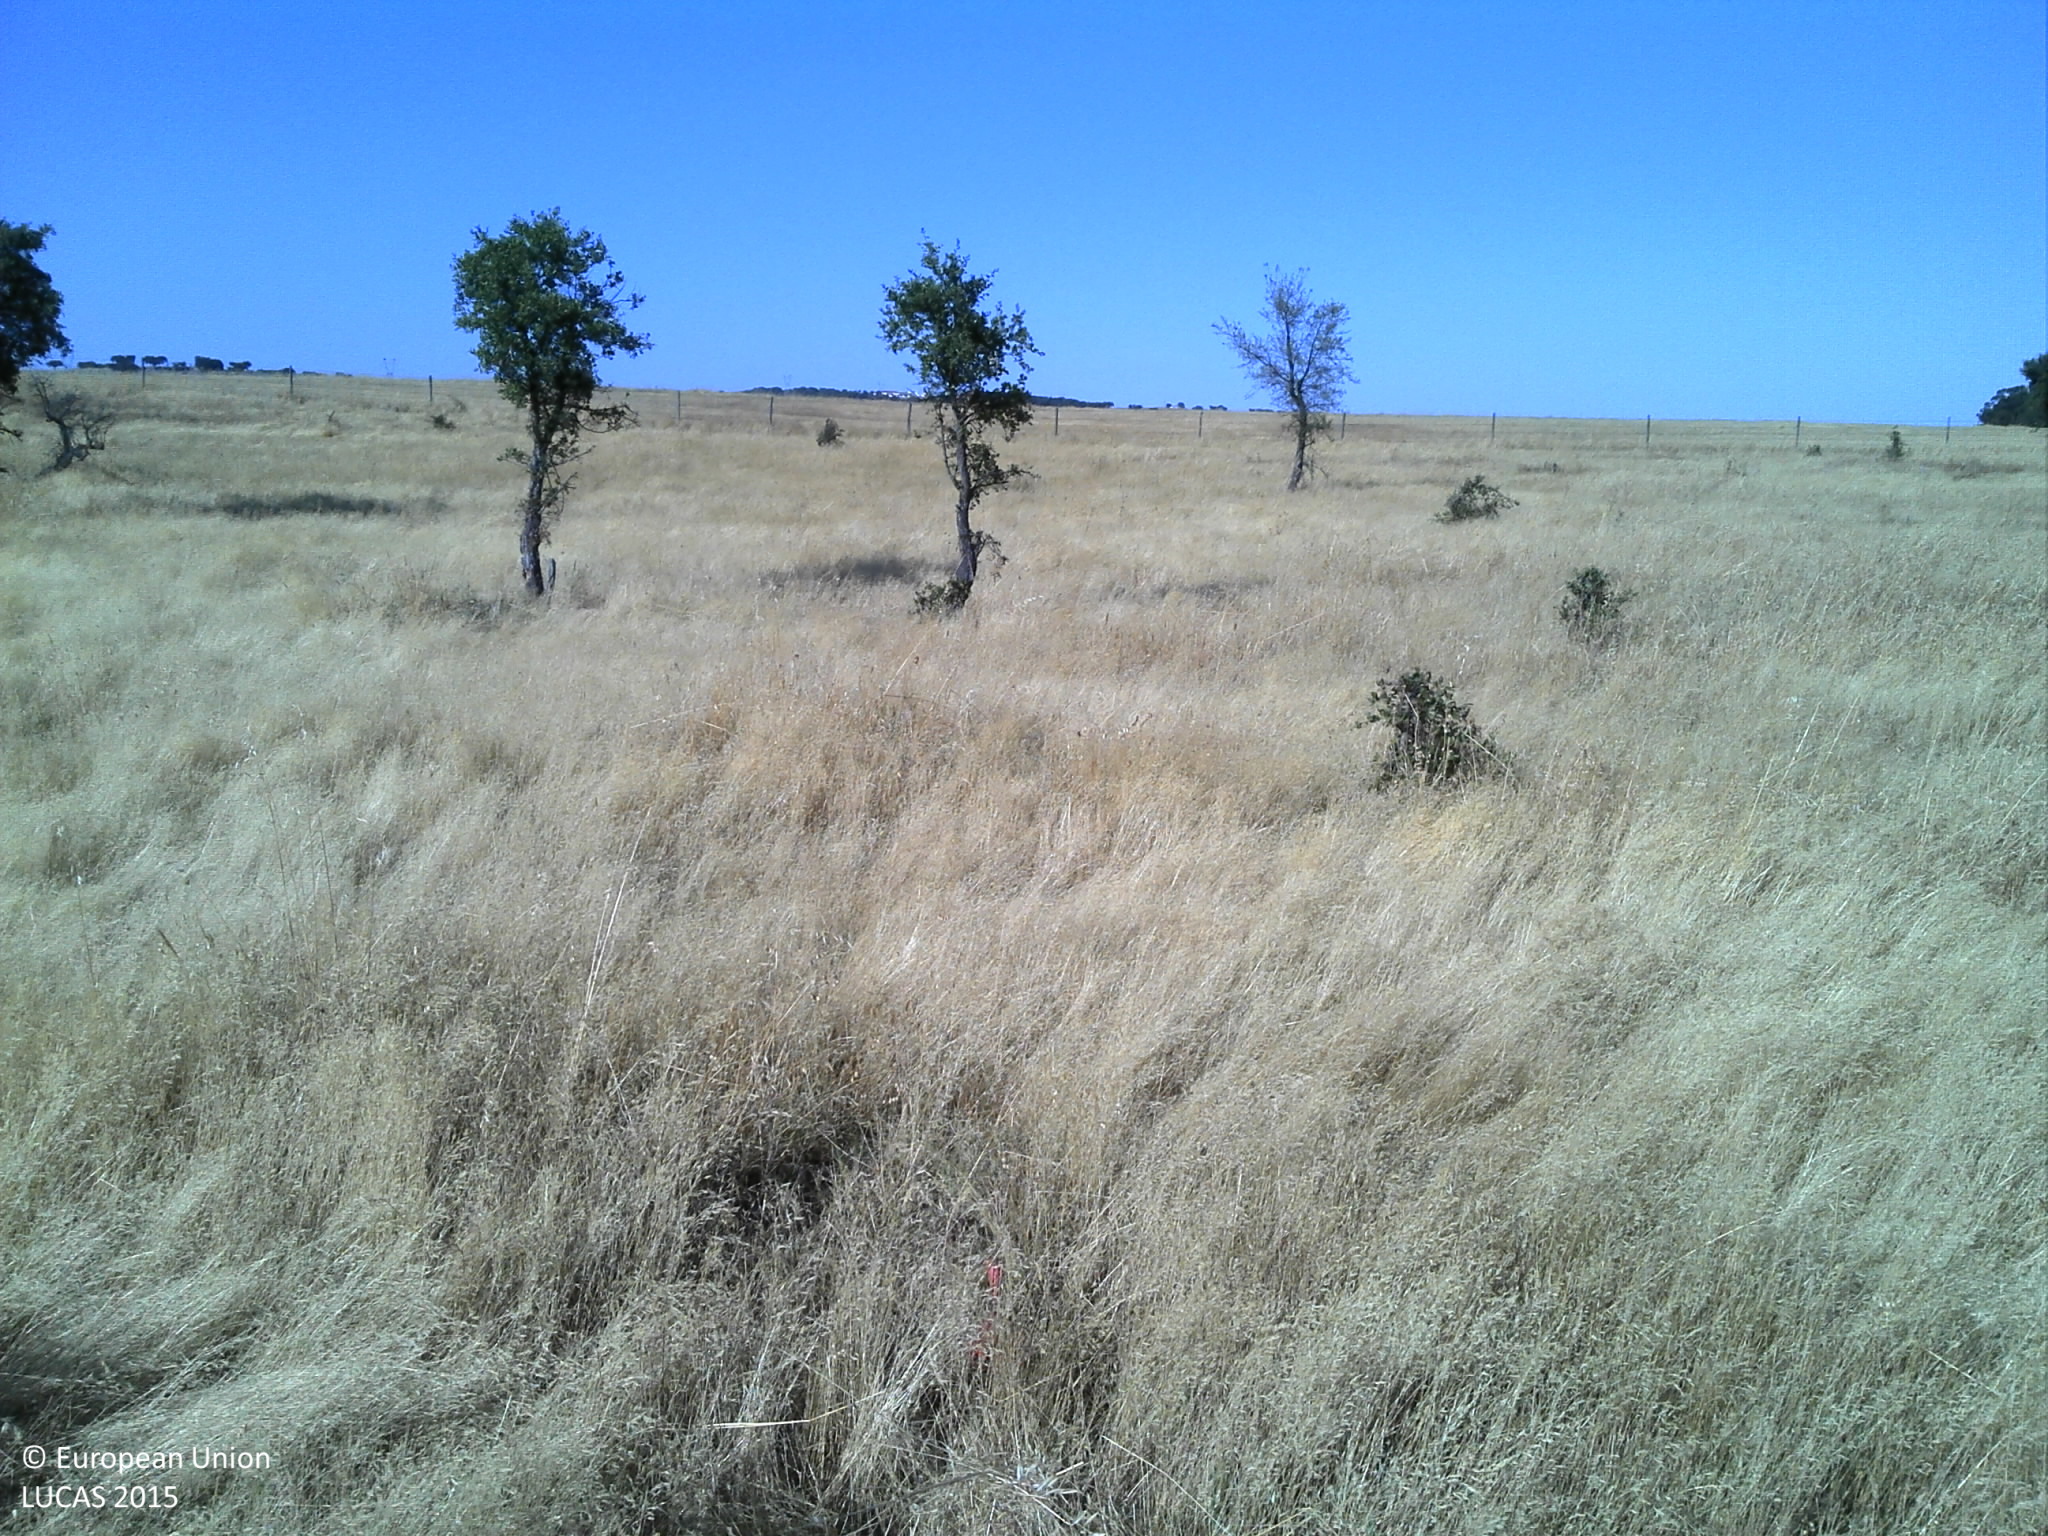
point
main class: Woodland
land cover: Broadleaved woodland
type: broadleaved evergreen forest
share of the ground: 10 - 25 %
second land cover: Grassland without tree/shrub cover
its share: 25 - 50 %
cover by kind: unconsolidated bare surface 65 %, herbaceous plants 25 %, broadleaved forest trees 10 %
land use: Forestry
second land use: Agriculture (excluding fallow land and kitchen gardens)
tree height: < 5 m
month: June
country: PT
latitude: 38.4624
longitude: -7.9746
